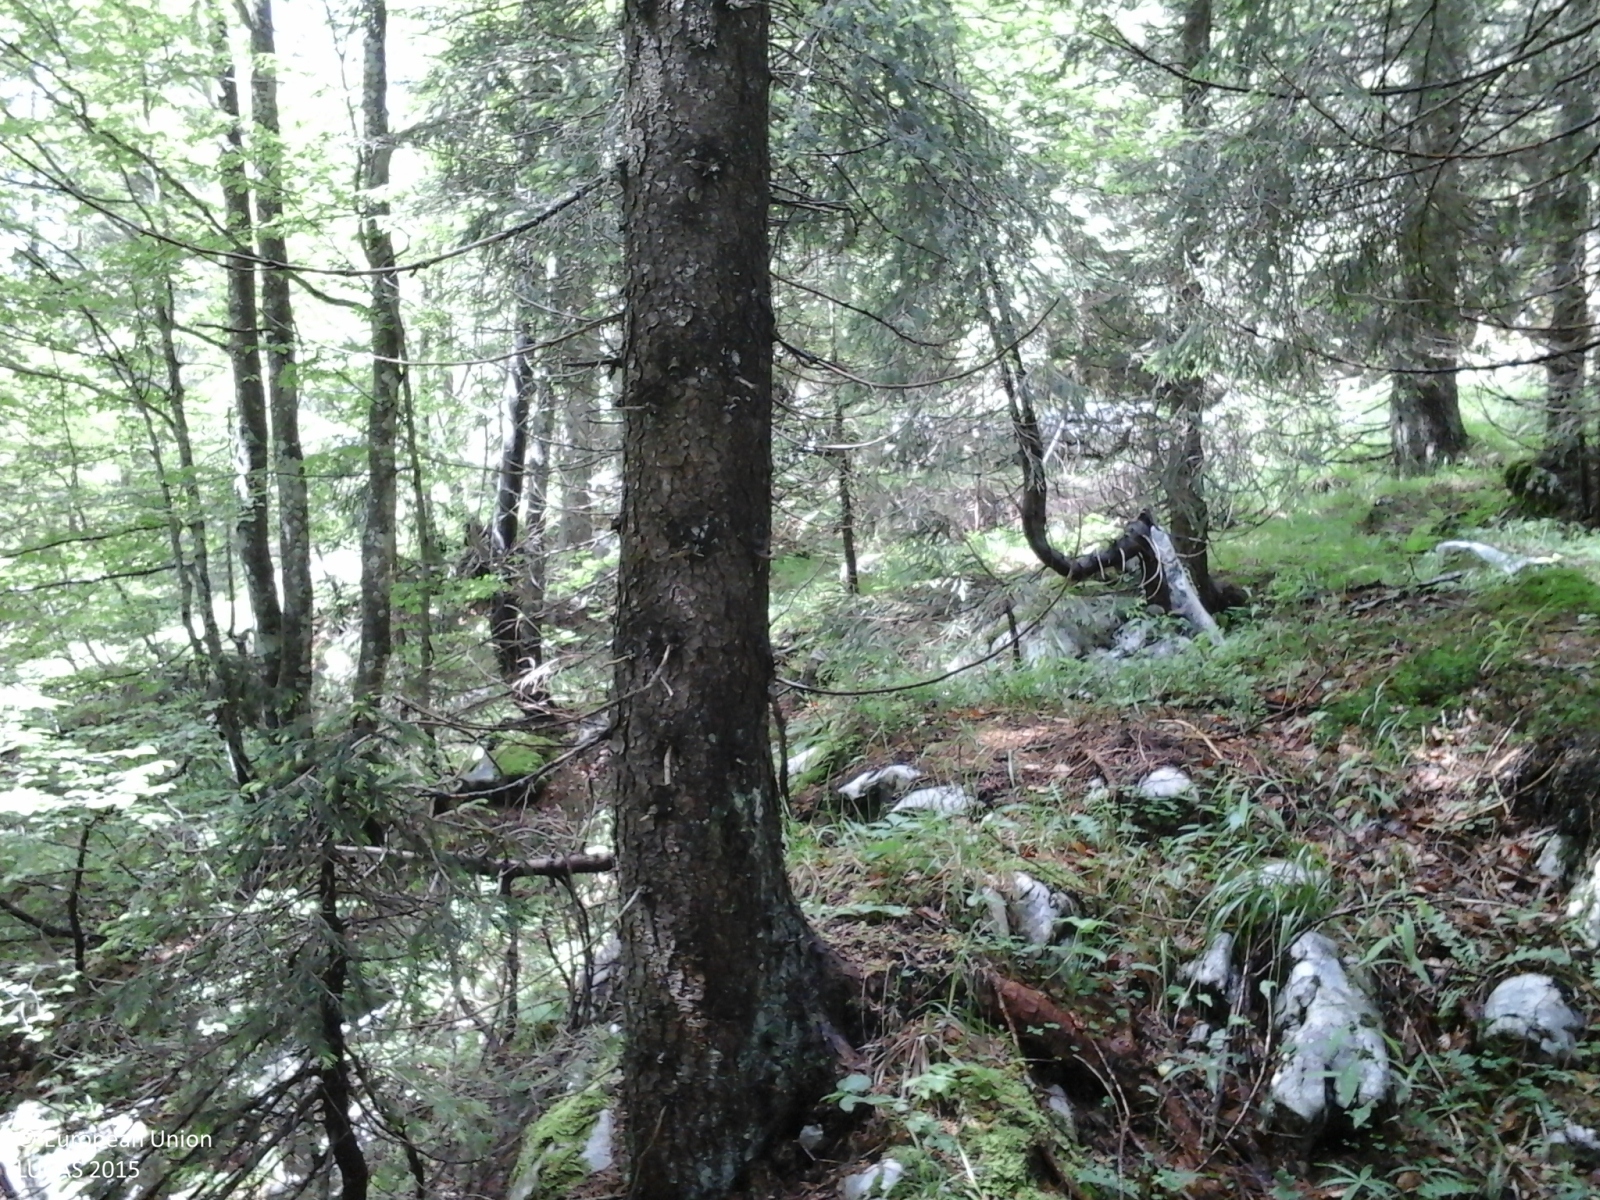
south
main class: Woodland
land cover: Spruce dominated coniferous woodland
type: alpine coniferous forest
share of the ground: > 75 %
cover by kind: coniferous forest trees 100 %
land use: Forestry
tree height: > 5 m
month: June
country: IT
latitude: 45.9438
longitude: 11.5328
